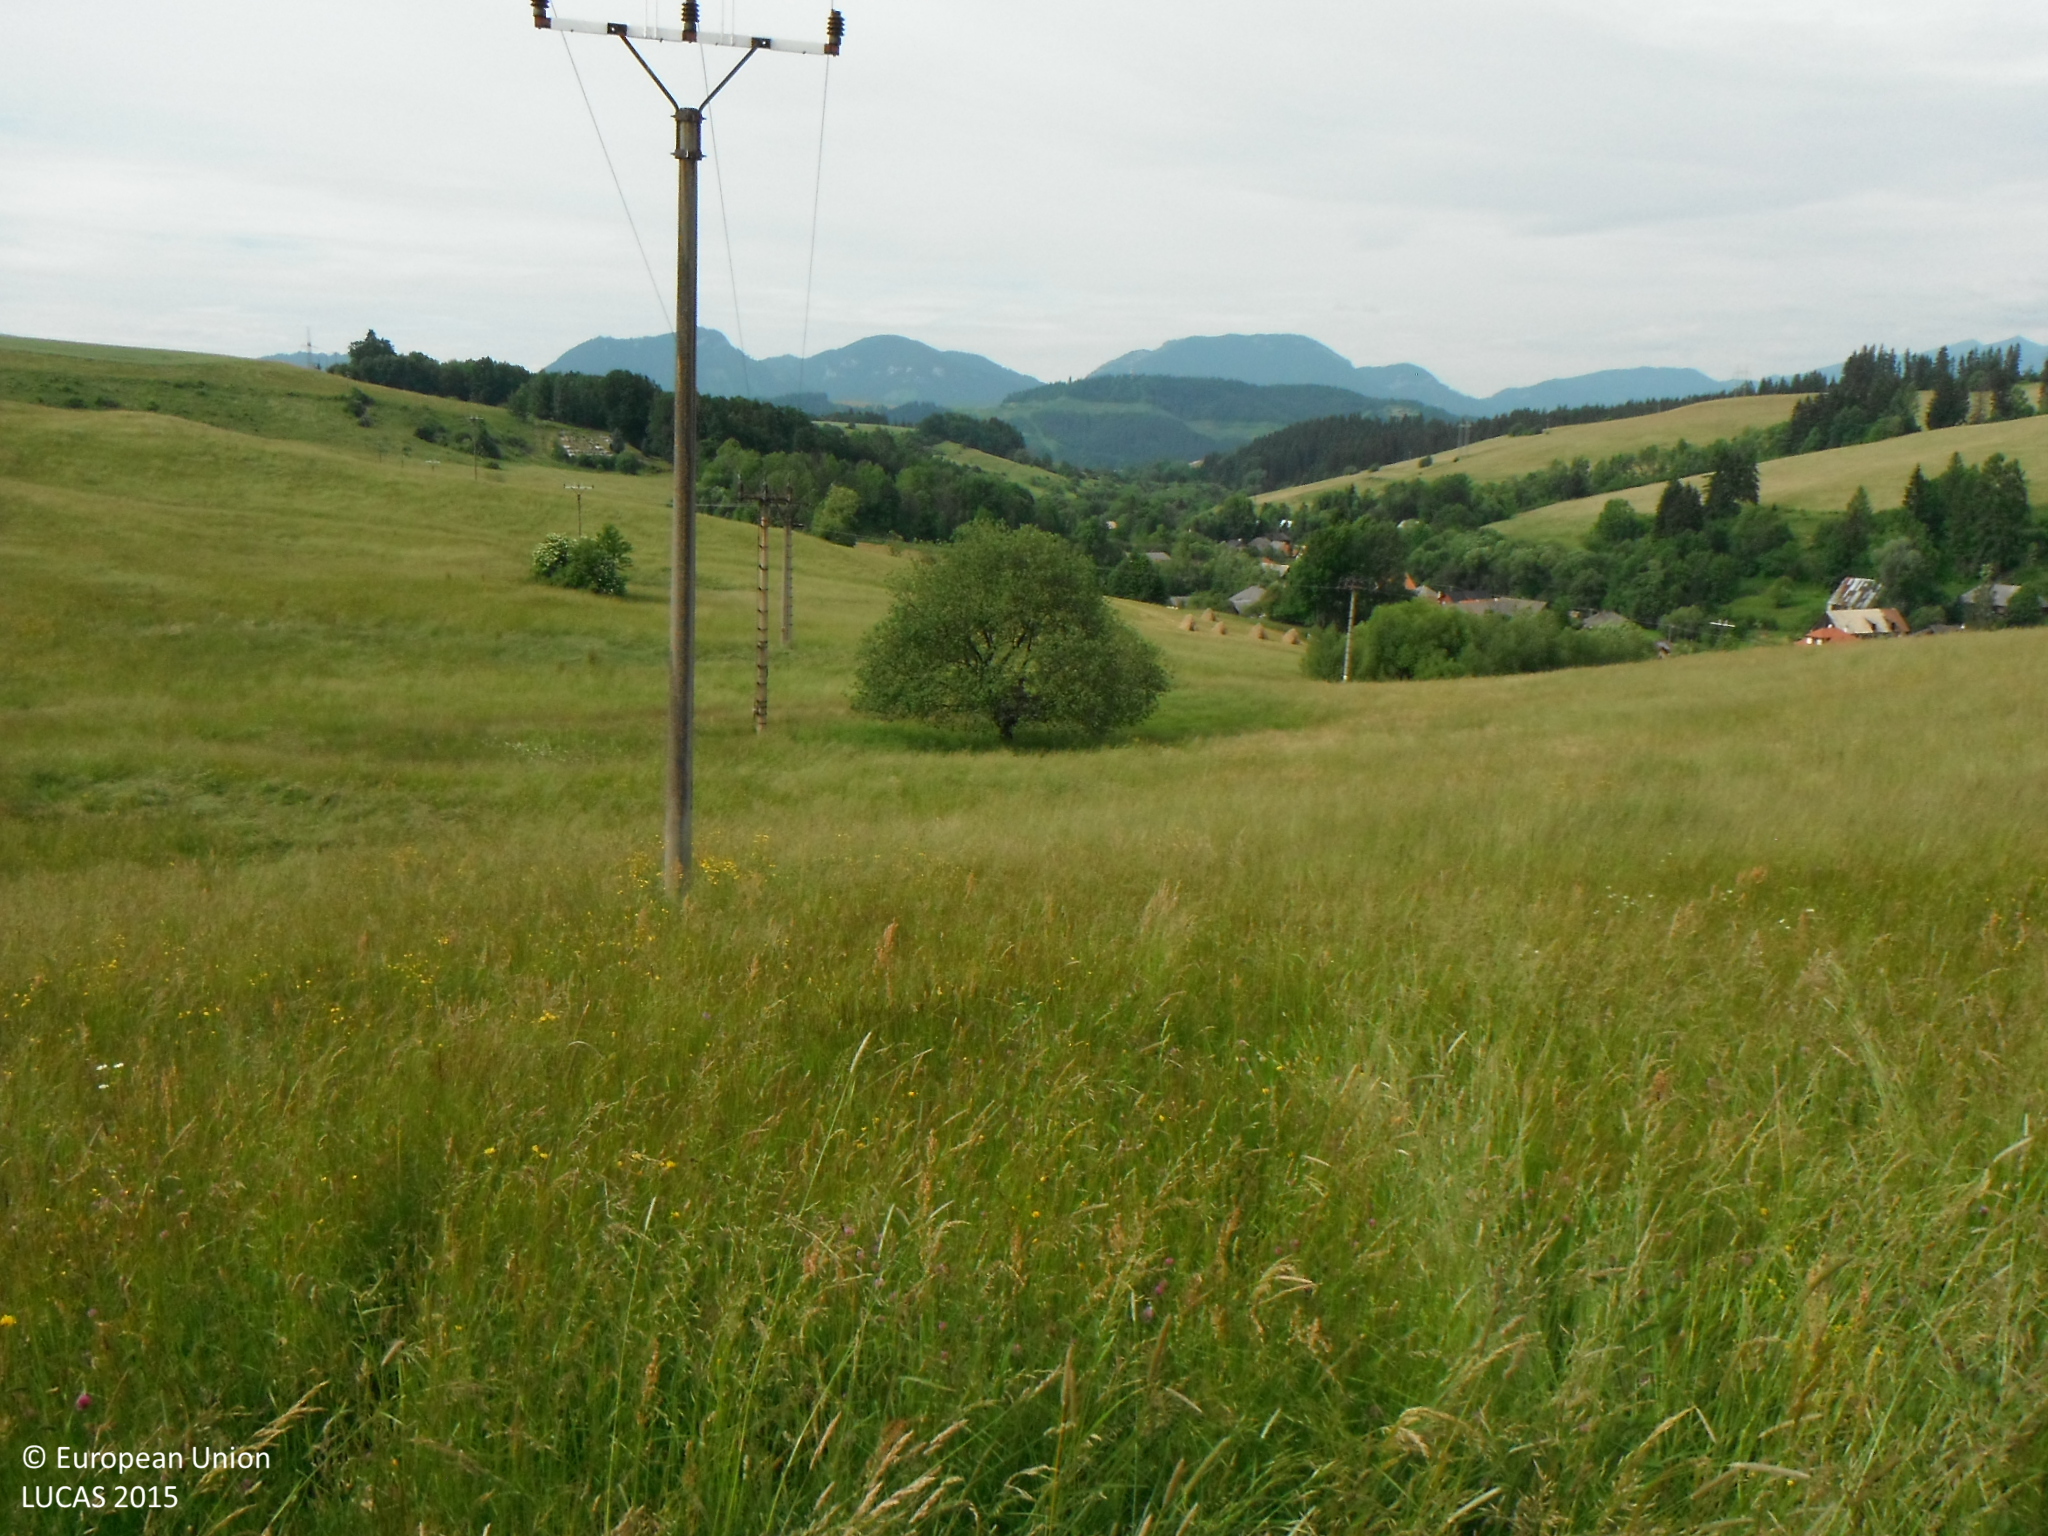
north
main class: Grassland
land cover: Grassland without tree/shrub cover
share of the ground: > 75 %
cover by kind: herbaceous plants 100 %
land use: Agriculture (excluding fallow land and kitchen gardens)
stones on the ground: < 10 %
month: June
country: SK
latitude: 49.0661
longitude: 19.4560
